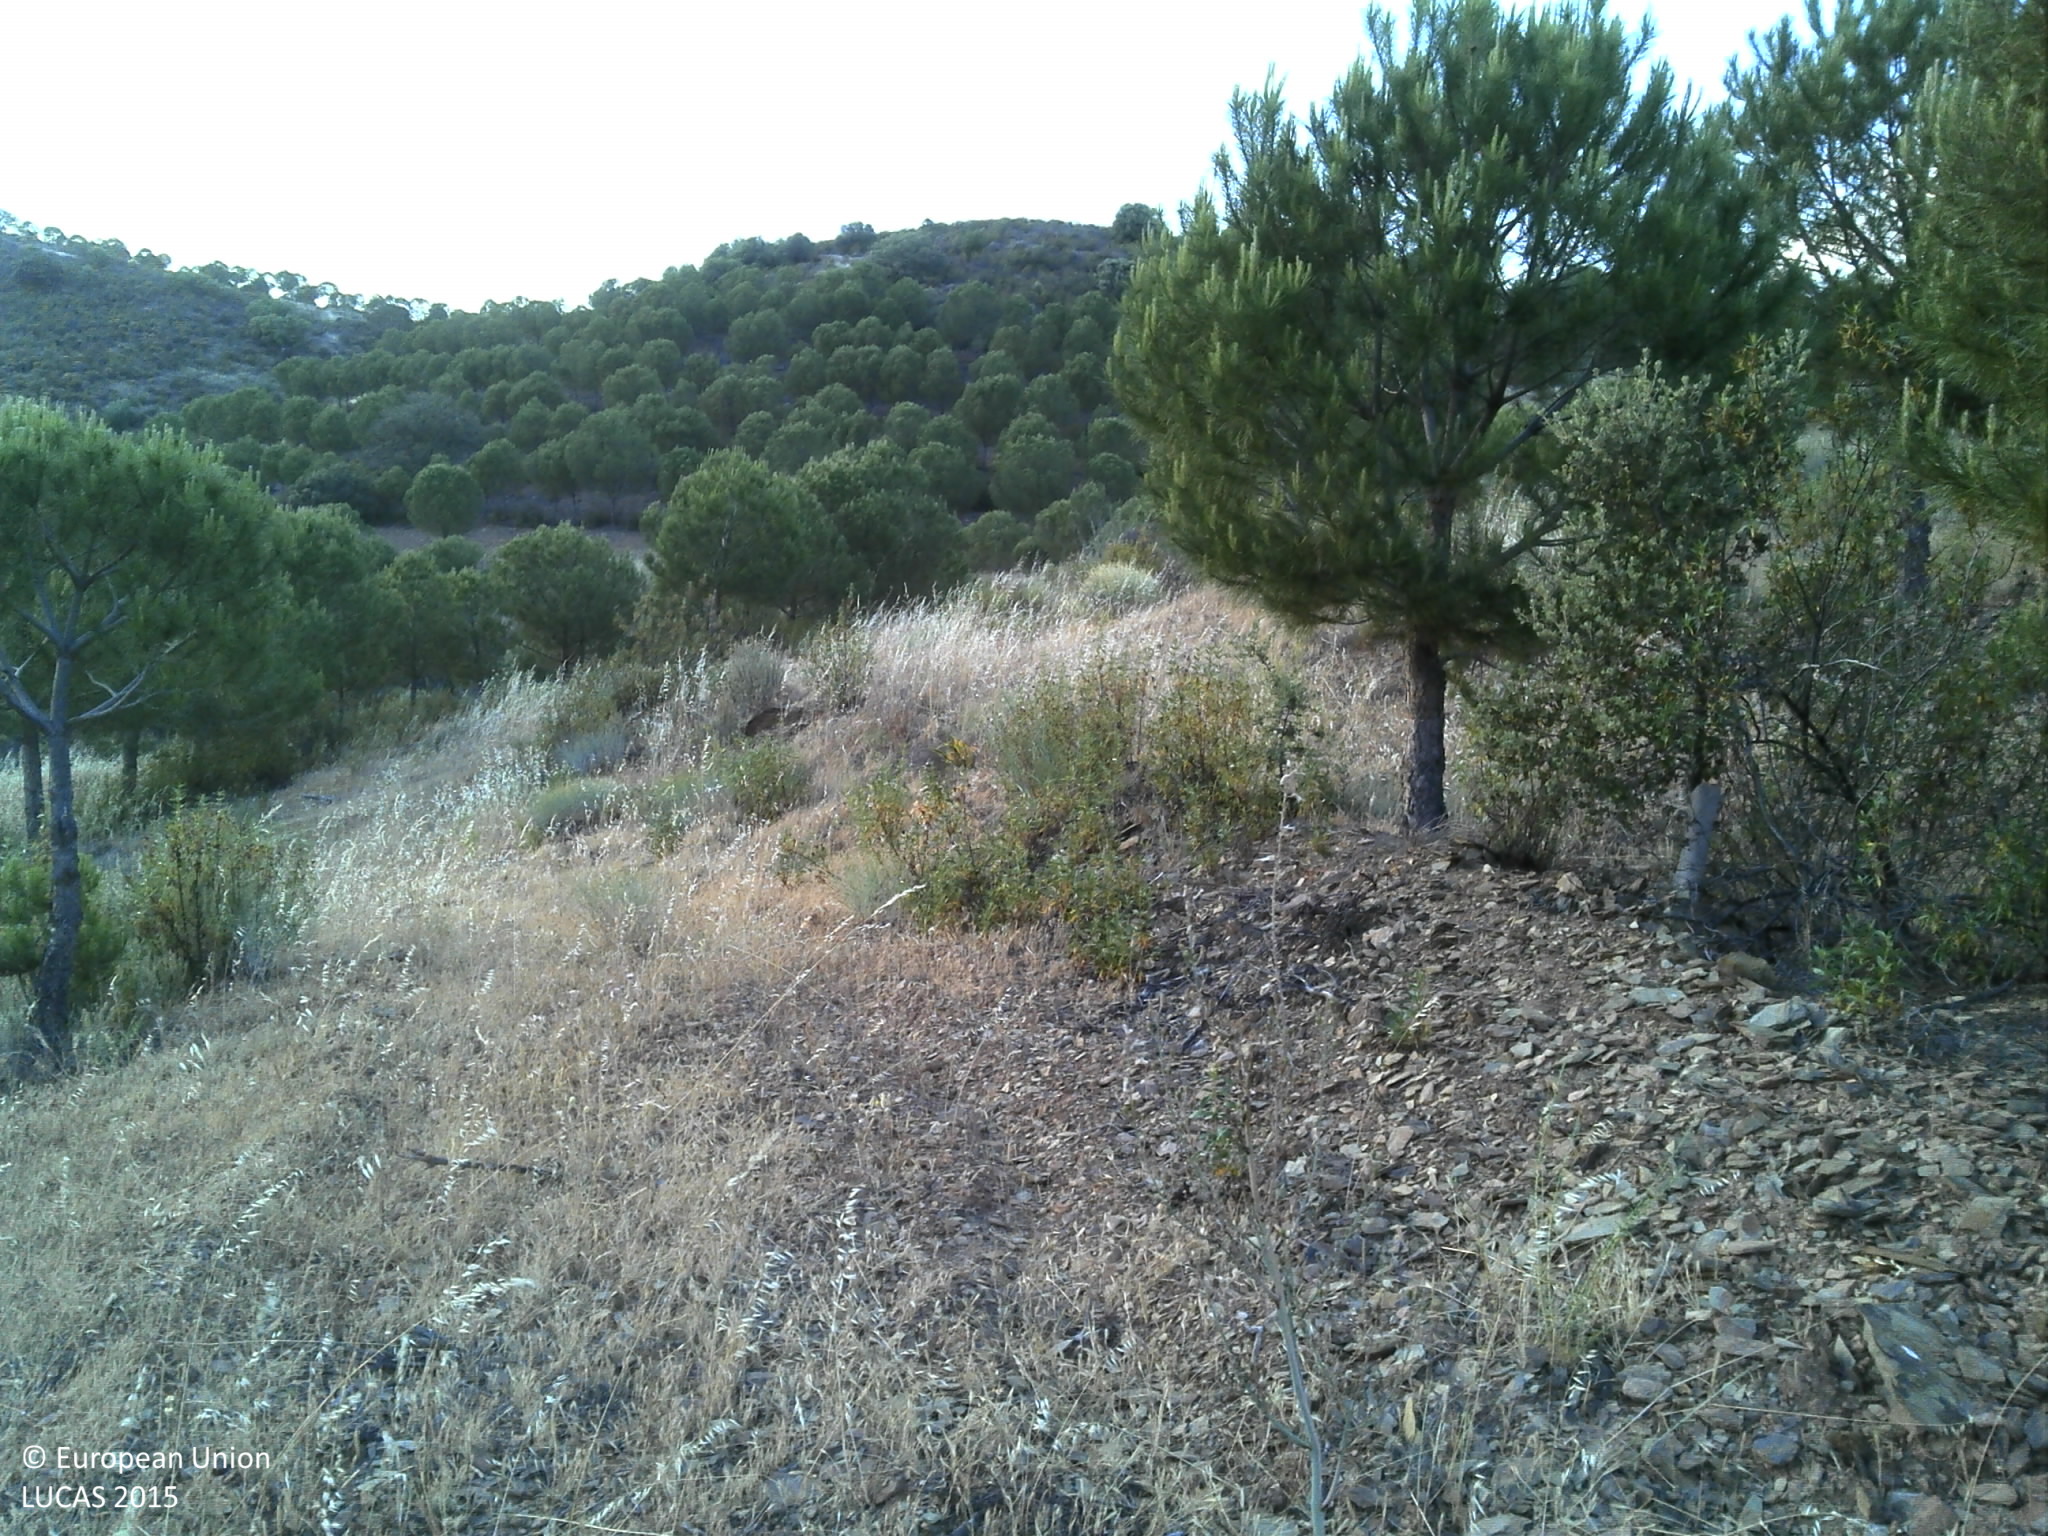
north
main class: Woodland
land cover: Pine dominated coniferous woodland
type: coniferous forest of the mediterranean region
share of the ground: 10 - 25 %
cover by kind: herbaceous plants 60 %, coniferous forest trees 25 %, consolidated bare surface 10 %, shrubs 5 %
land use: Forestry
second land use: Agriculture (excluding fallow land and kitchen gardens)
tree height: < 5 m
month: May
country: PT
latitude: 37.4863
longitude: -7.7592
